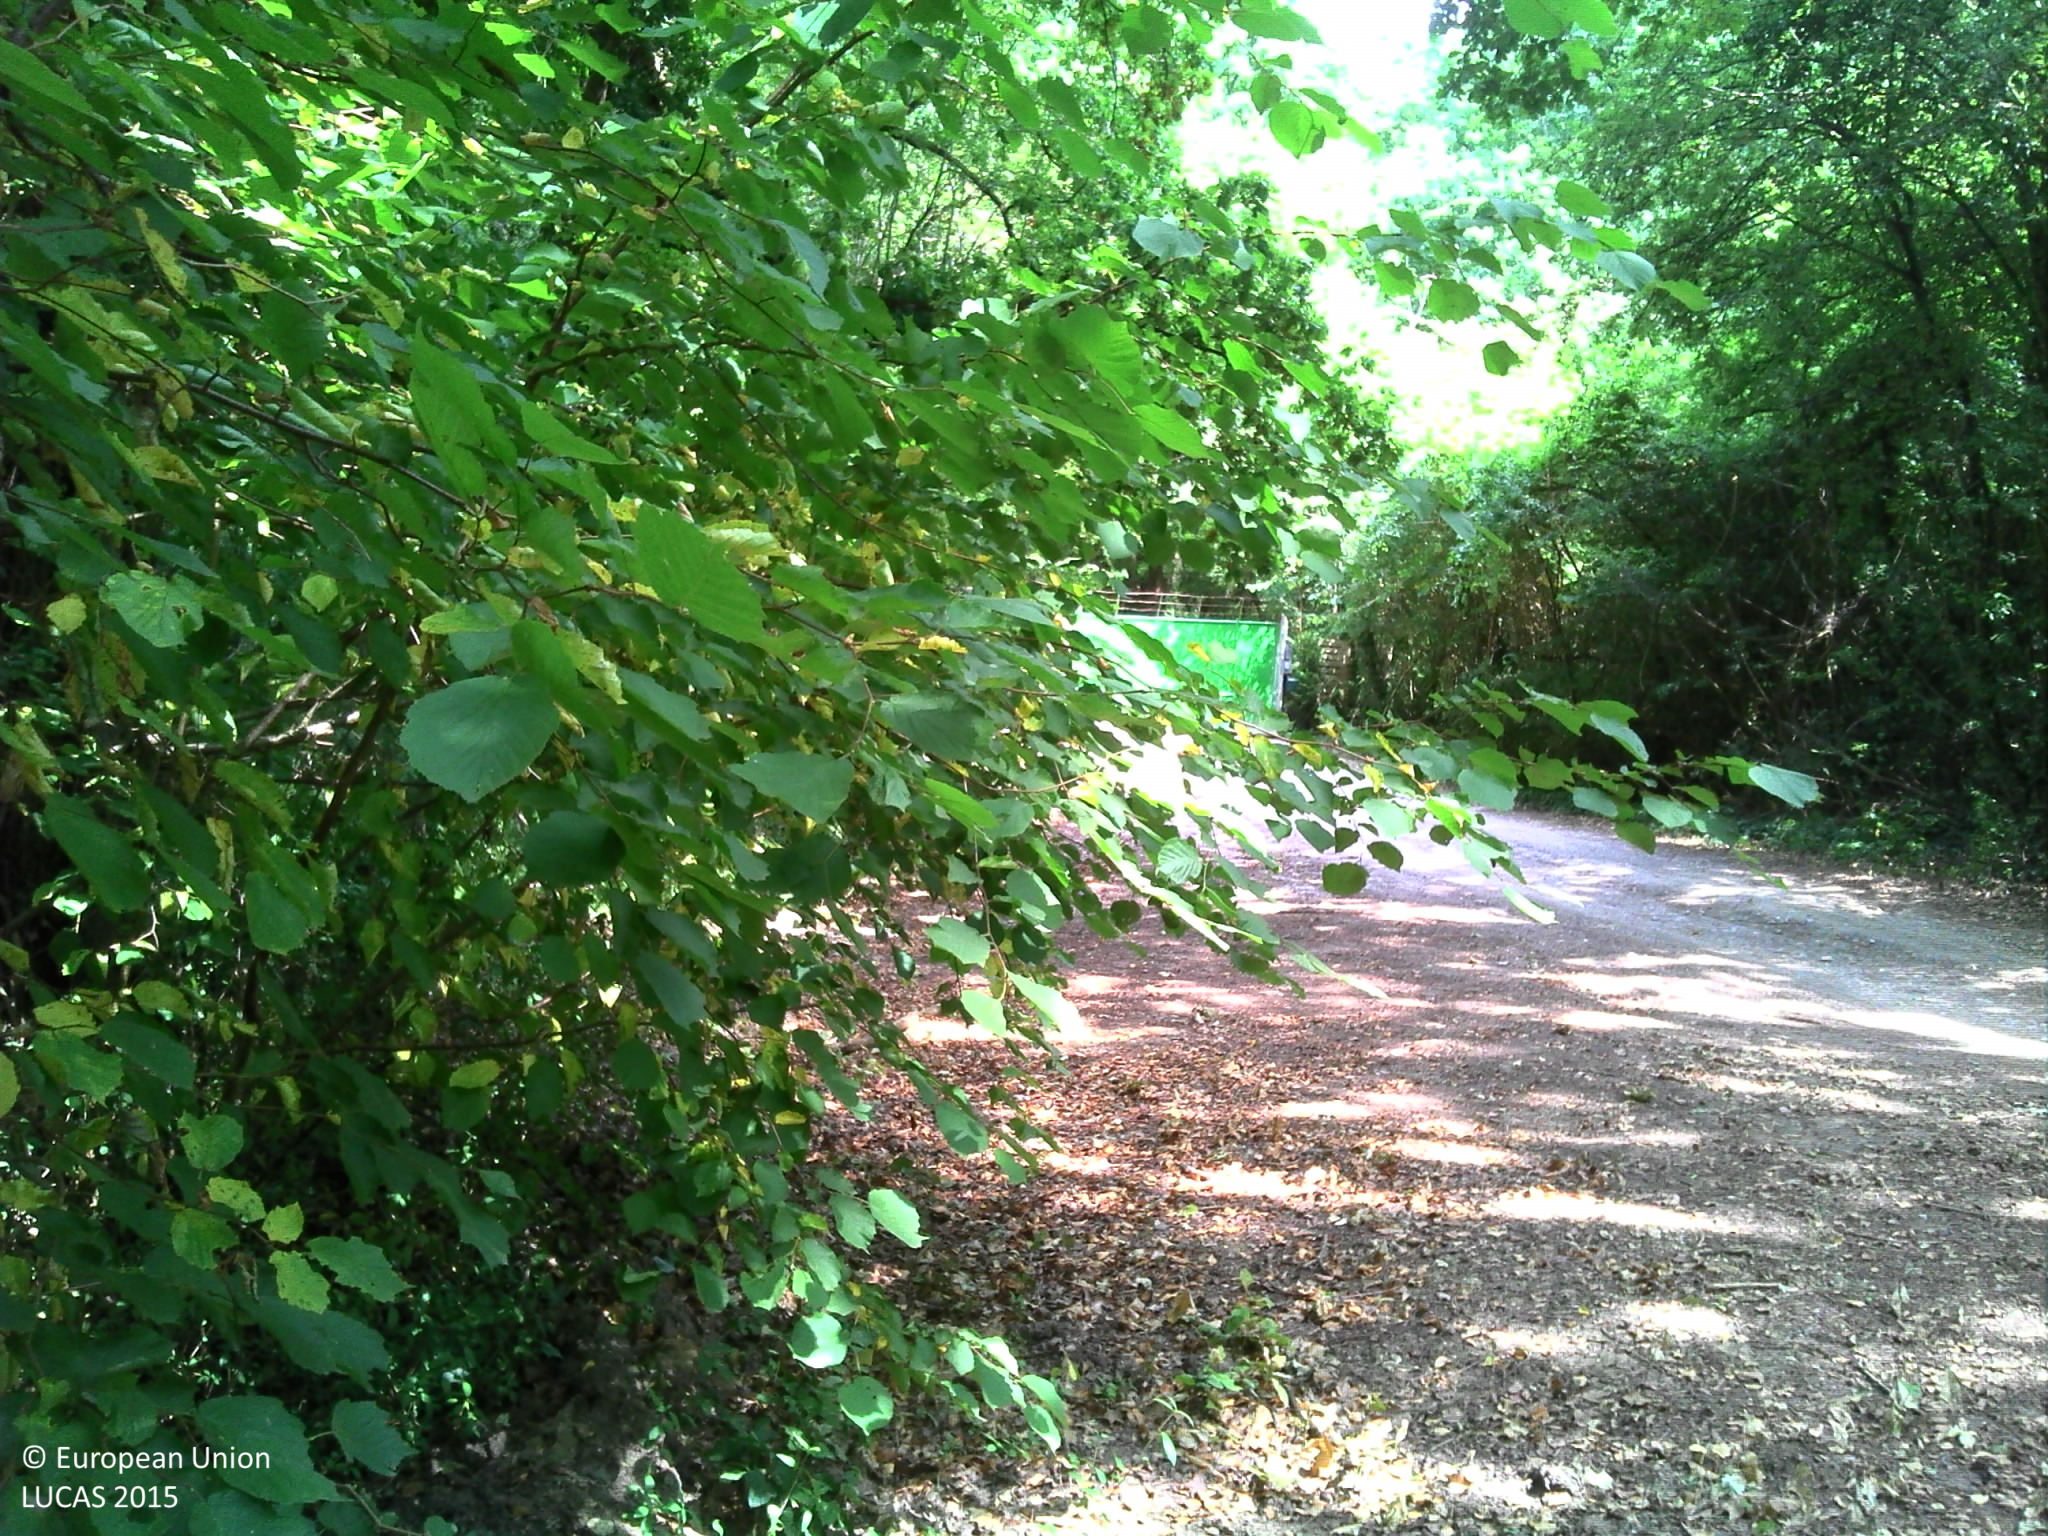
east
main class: Woodland
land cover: Broadleaved woodland
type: beech forest
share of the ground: > 75 %
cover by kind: broadleaved forest trees 55 %, herbaceous plants 35 %, shrubs 5 %, unconsolidated bare surface 5 %
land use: Residential
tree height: > 5 m
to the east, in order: Broadleaved woodland; Fences; Tracks; Broadleaved woodland; Tracks; Broadleaved woodland; Artificial constructions in urban areas
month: August
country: FR
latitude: 48.3635
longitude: 2.4714
